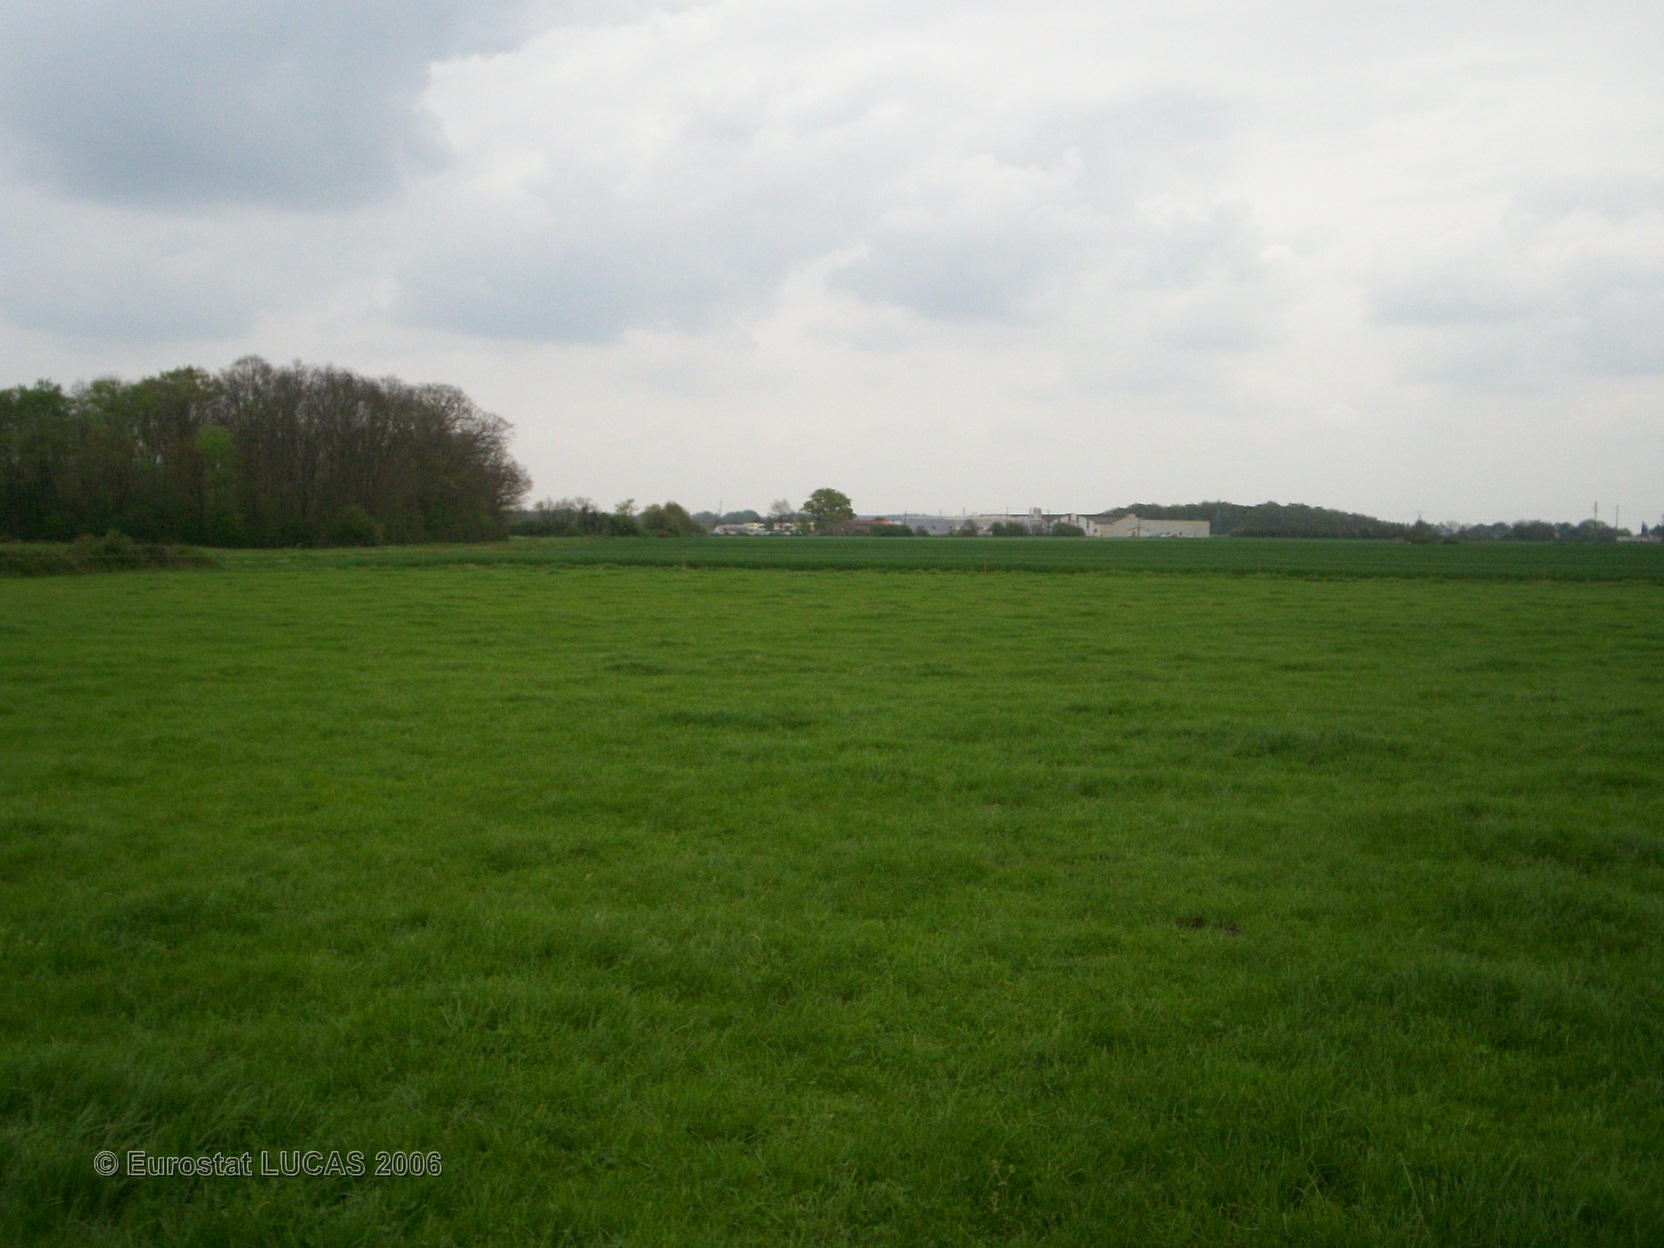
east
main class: Grassland
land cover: Grassland without tree/shrub cover
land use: Agriculture (excluding fallow land and kitchen gardens)
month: April
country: FR
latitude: 46.8382
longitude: -1.3265
